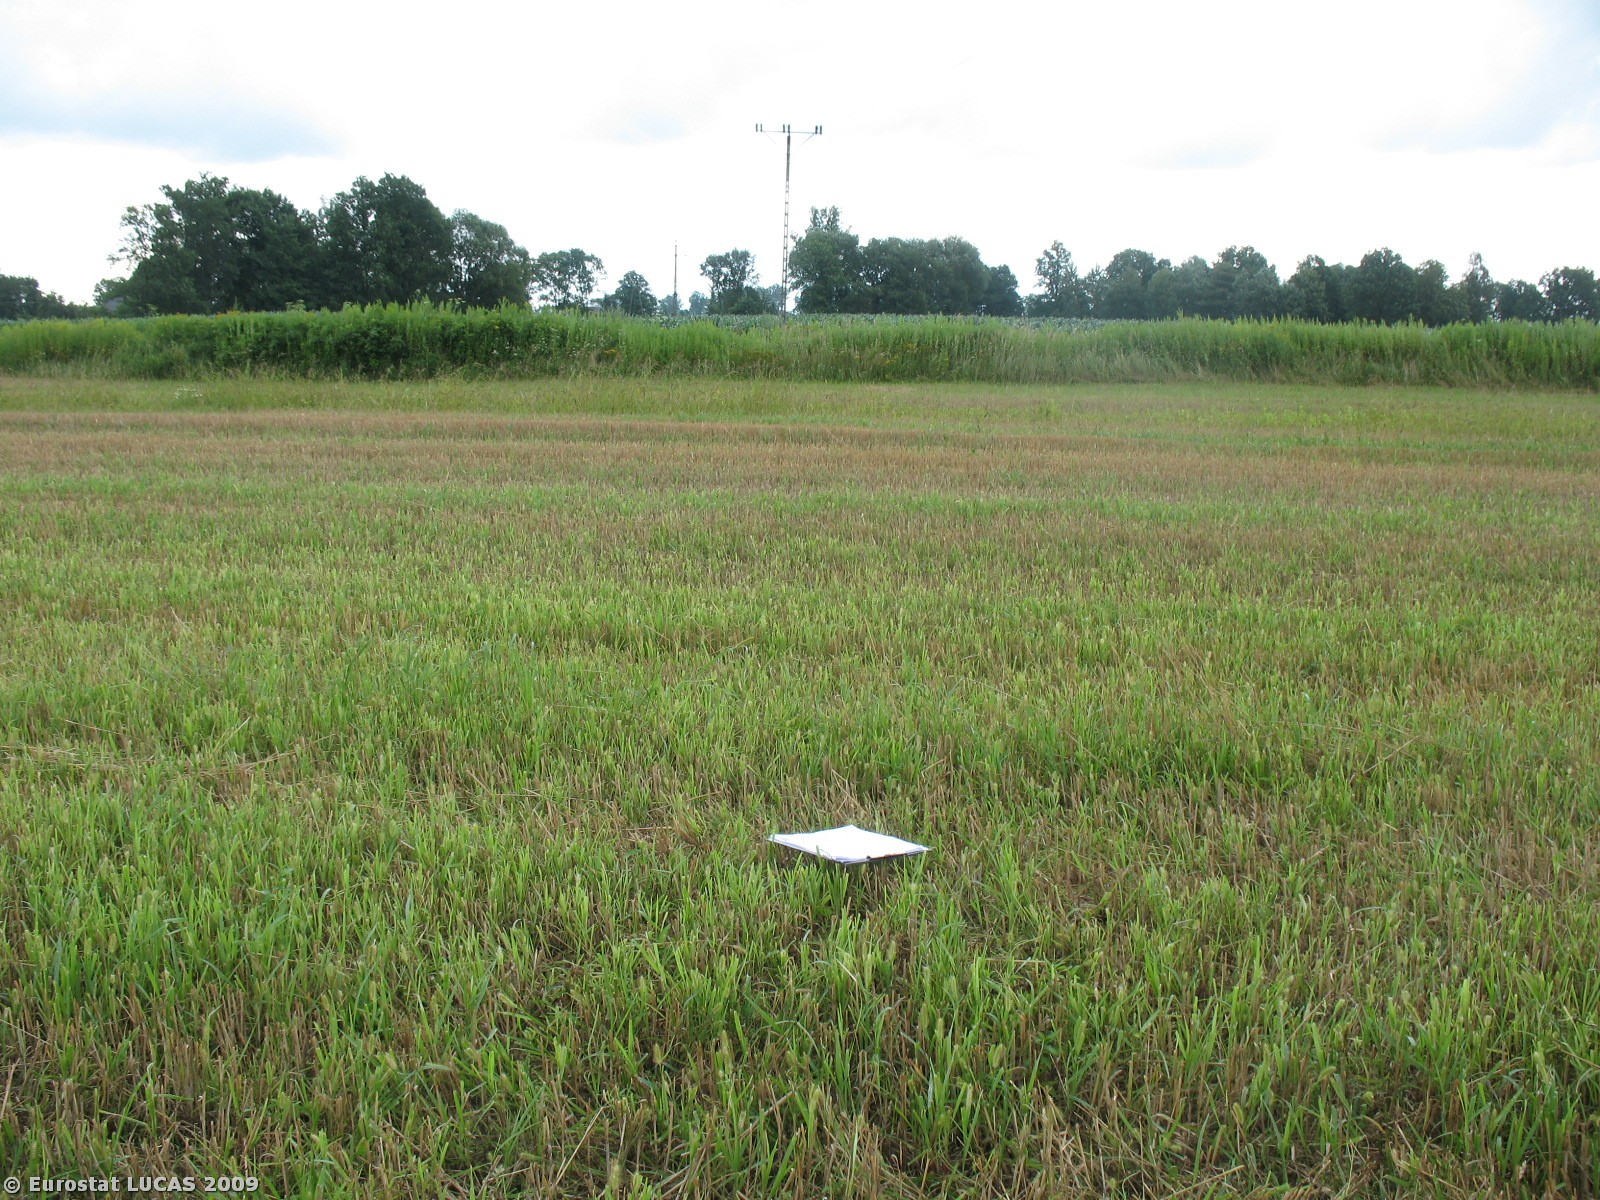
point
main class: Cropland
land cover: Common wheat
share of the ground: < 10 %
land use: Agriculture (excluding fallow land and kitchen gardens)
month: July
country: PL
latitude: 50.2237
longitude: 22.6406
